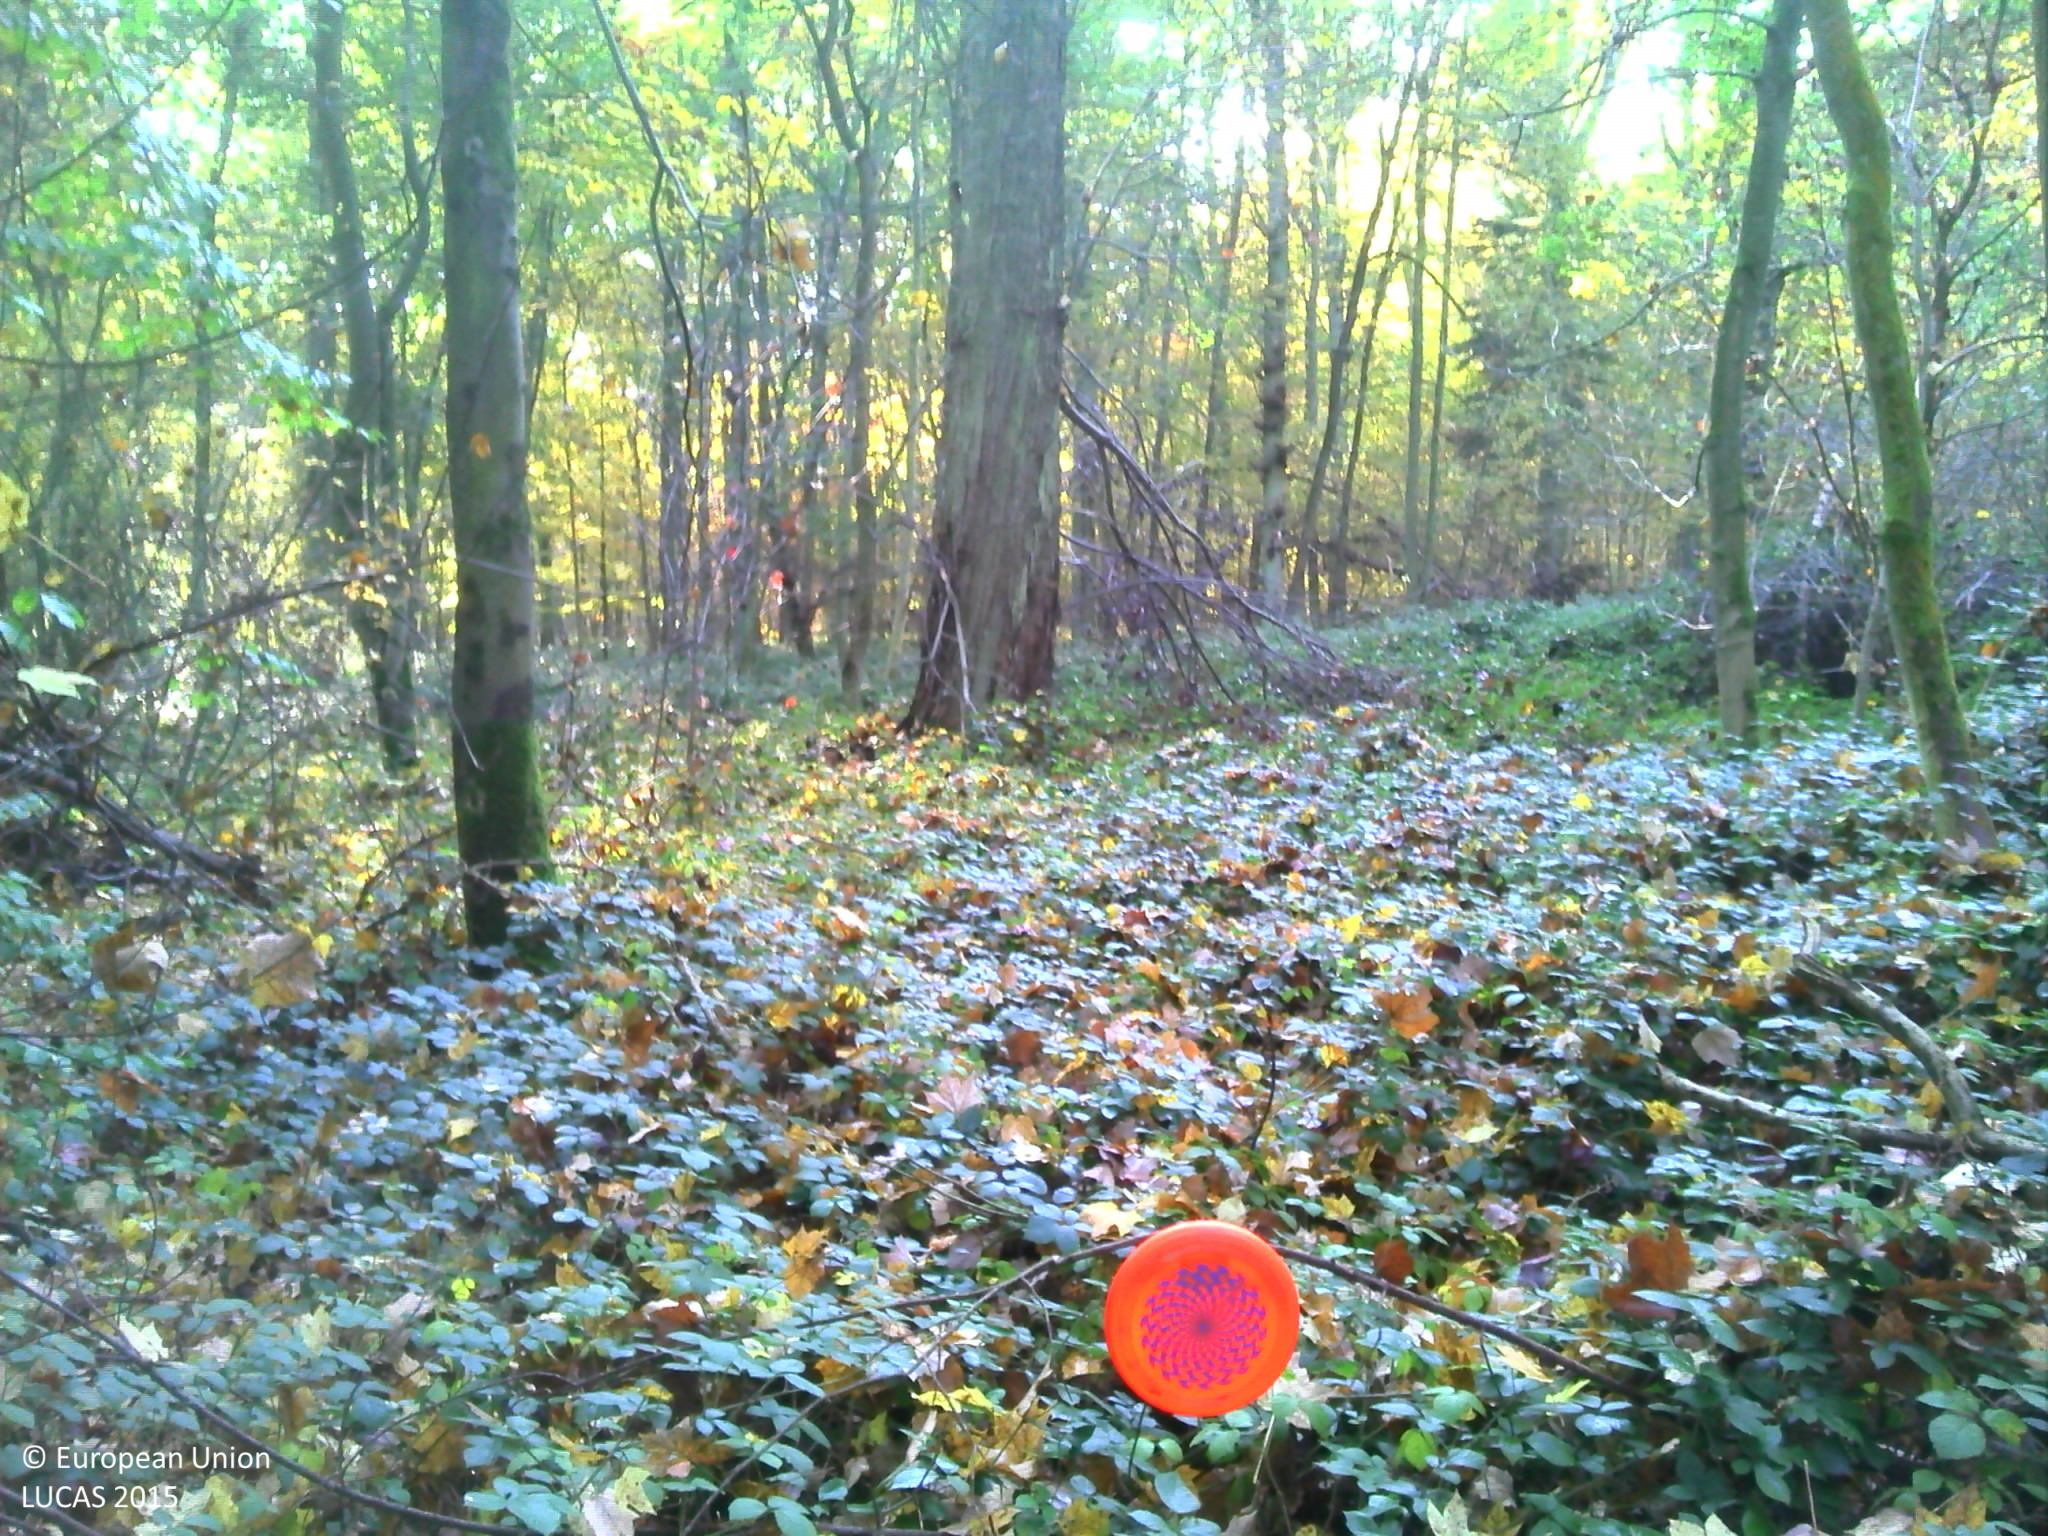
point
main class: Woodland
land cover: Broadleaved woodland
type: mesophytic deciduous forest
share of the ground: > 75 %
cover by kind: broadleaved forest trees 80 %, herbaceous plants 20 %
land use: Forestry
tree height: > 5 m
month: October
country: BE
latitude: 50.8087
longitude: 4.5038
